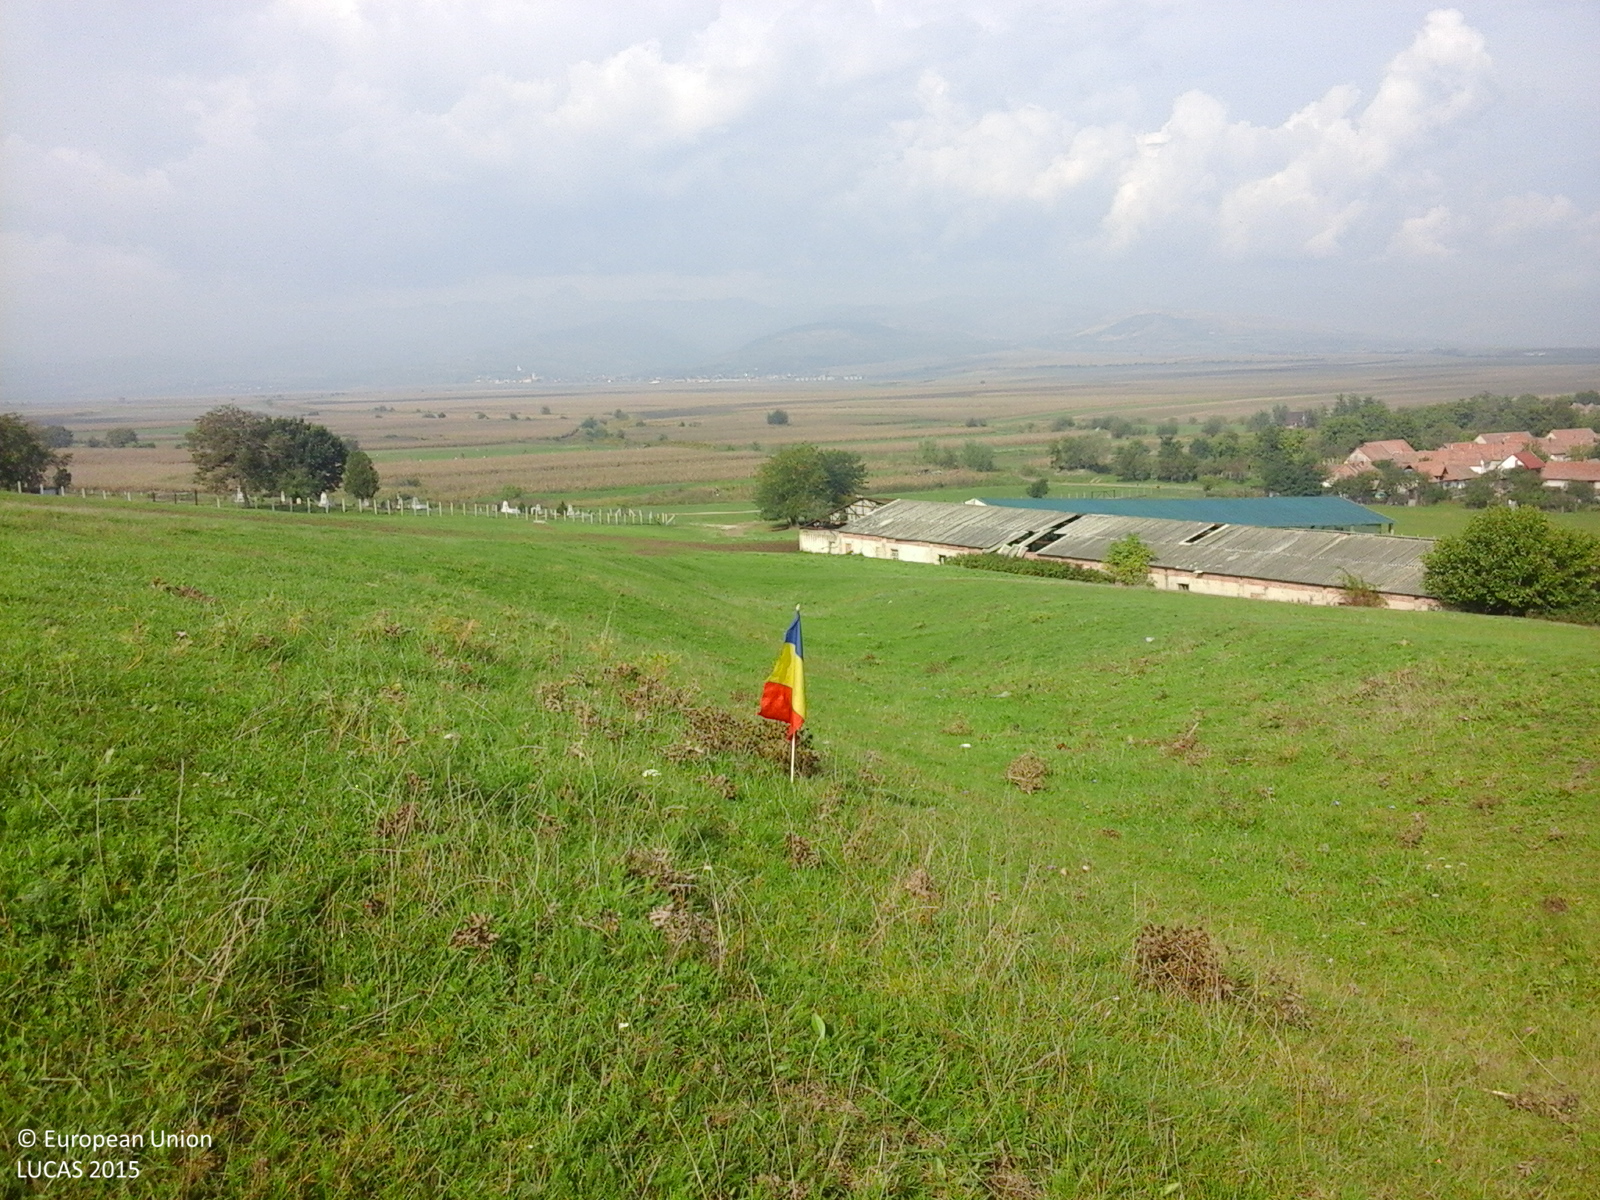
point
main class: Grassland
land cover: Grassland without tree/shrub cover
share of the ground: > 75 %
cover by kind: herbaceous plants 100 %
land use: Agriculture (excluding fallow land and kitchen gardens)
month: October
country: RO
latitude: 46.1501
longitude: 23.6237
